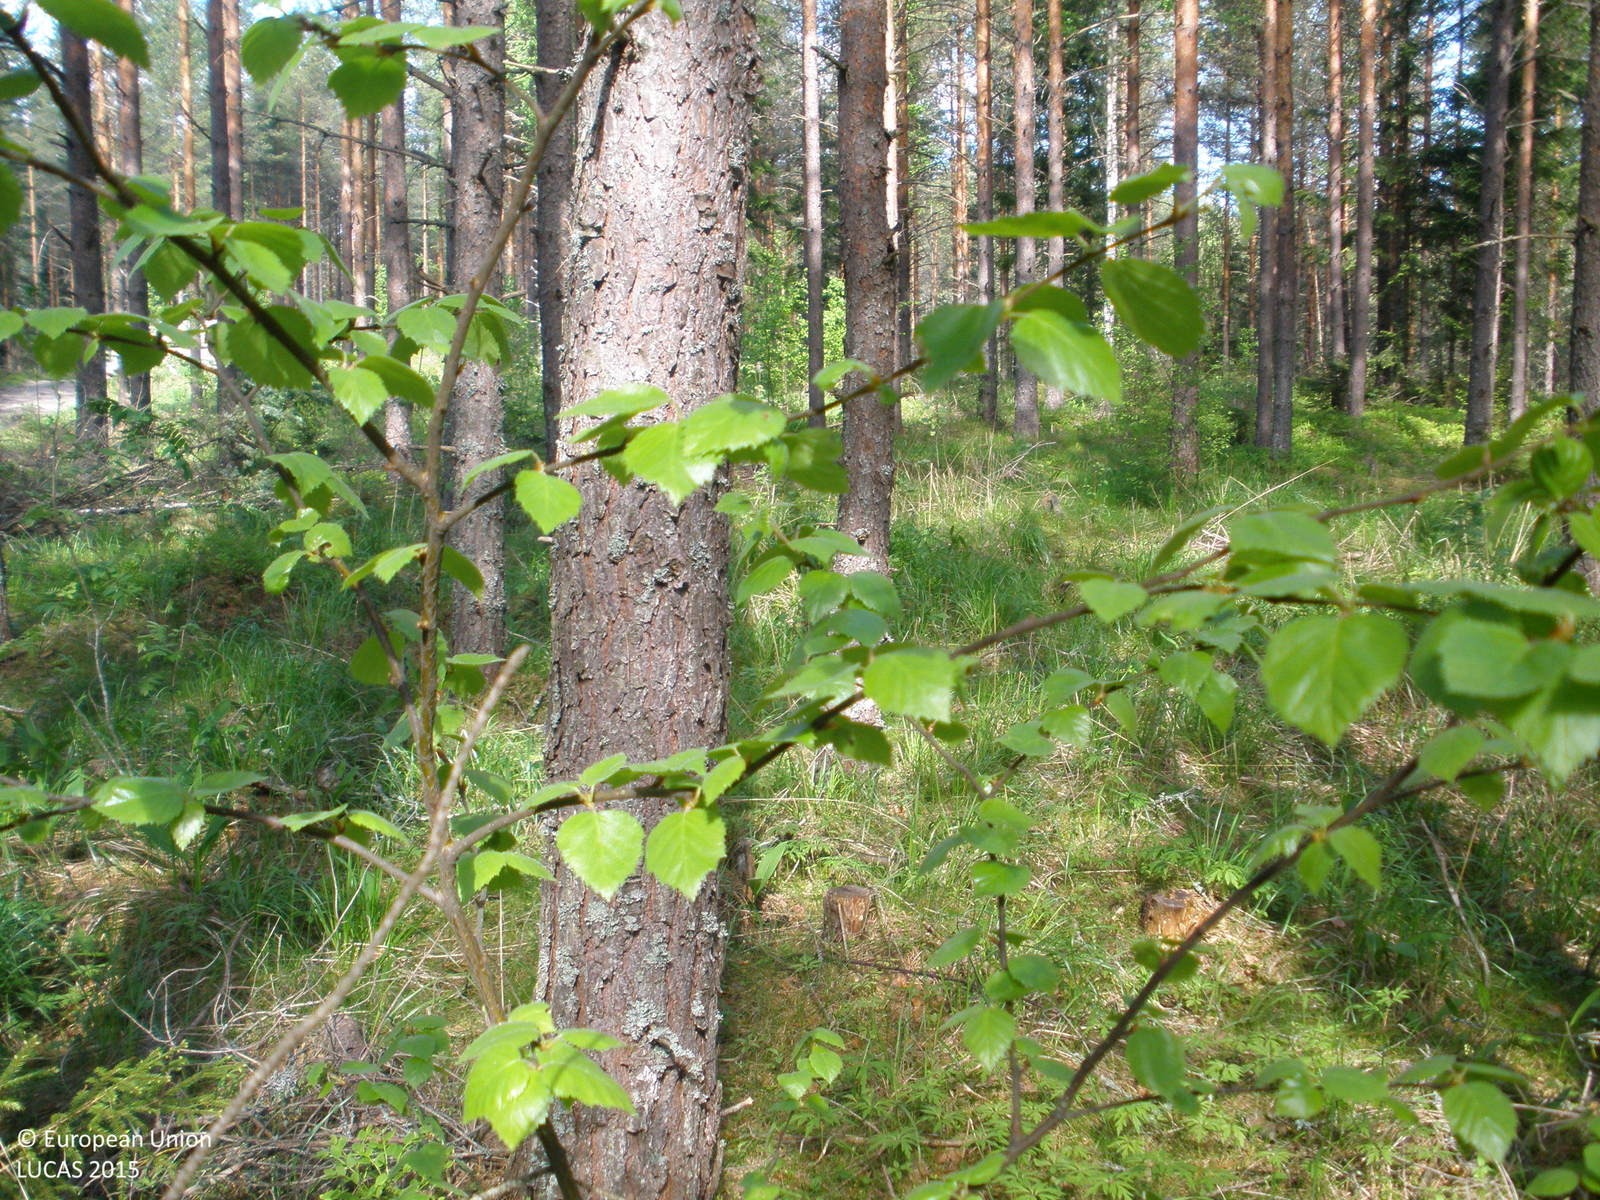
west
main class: Woodland
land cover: Pine dominated coniferous woodland
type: boreal forest
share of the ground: > 75 %
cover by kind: coniferous forest trees 80 %, lichens and mosses 10 %, broadleaved forest trees 5 %, herbaceous plants 5 %
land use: Forestry
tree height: > 5 m
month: June
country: FI
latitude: 60.7585
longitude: 24.0237
